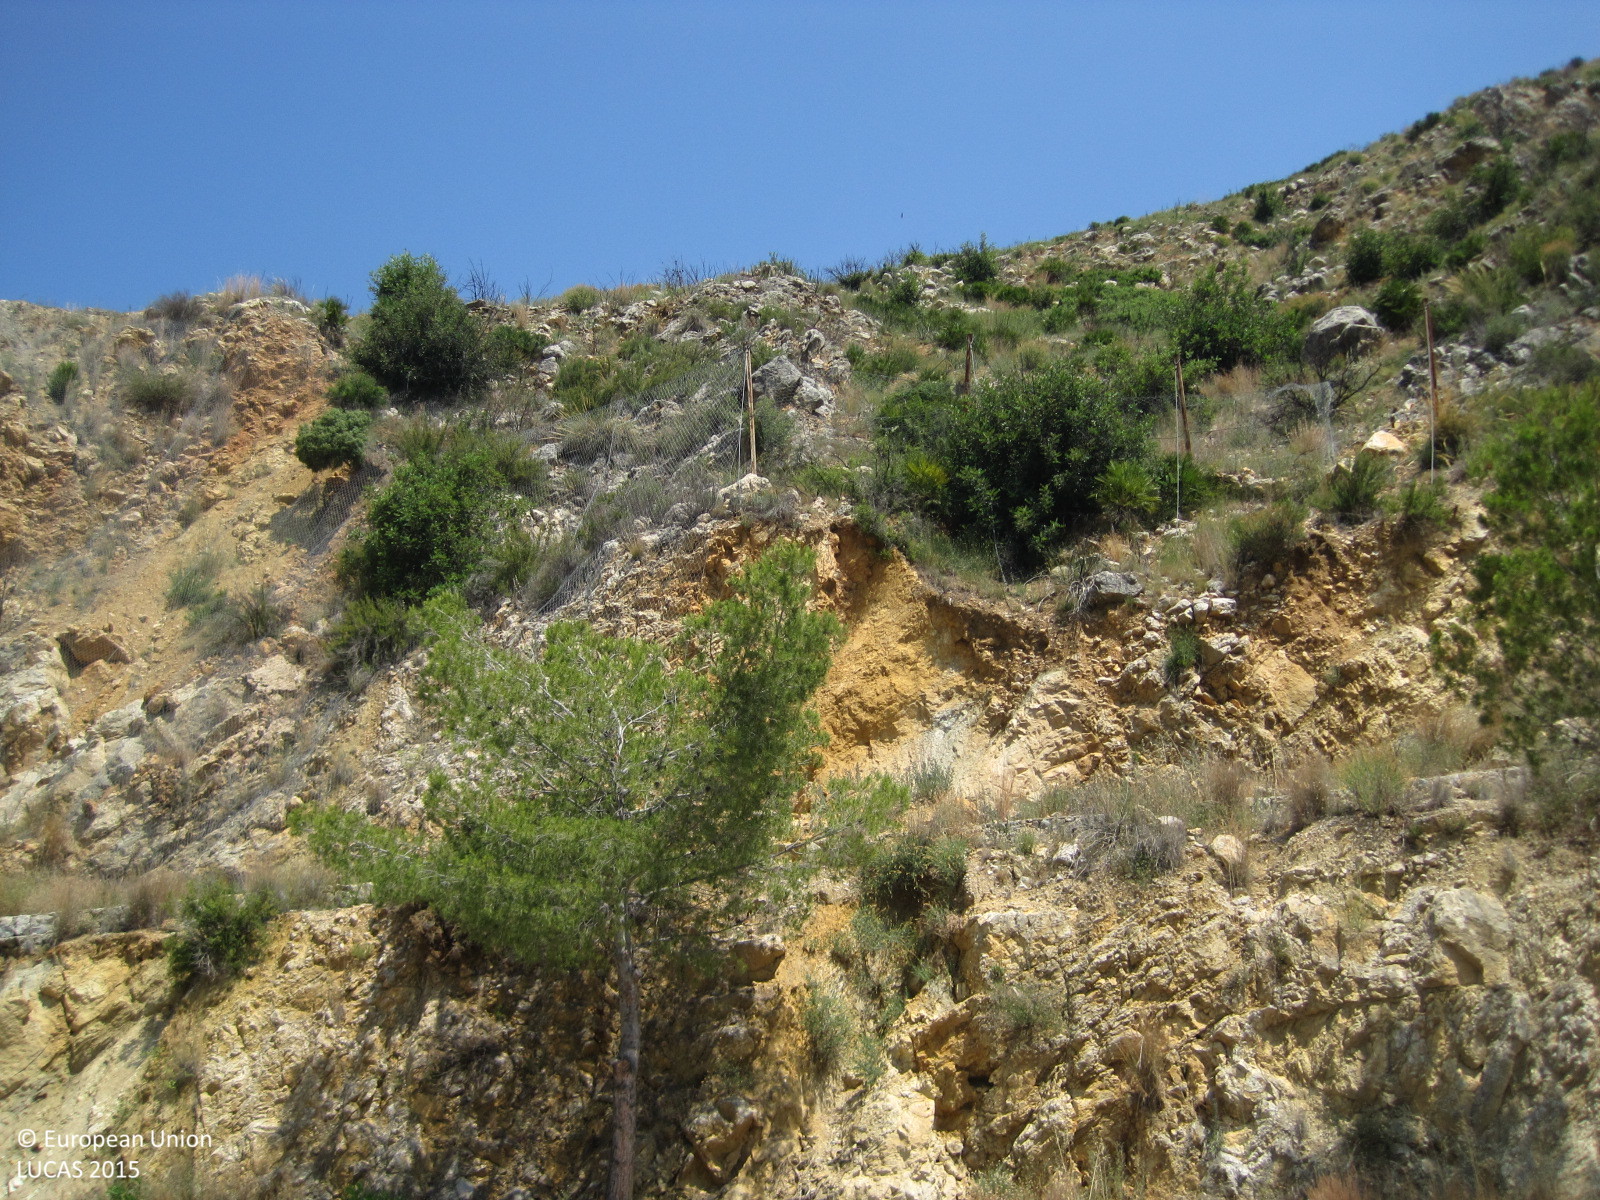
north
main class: Shrubland
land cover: Shrubland without tree cover
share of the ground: 25 - 50 %
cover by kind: lichens and mosses 50 %, shrubs 40 %, herbaceous plants 10 %
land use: Semi-natural and natural areas not in use
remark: Burnt area
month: June
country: ES
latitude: 39.2693
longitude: -0.7881
